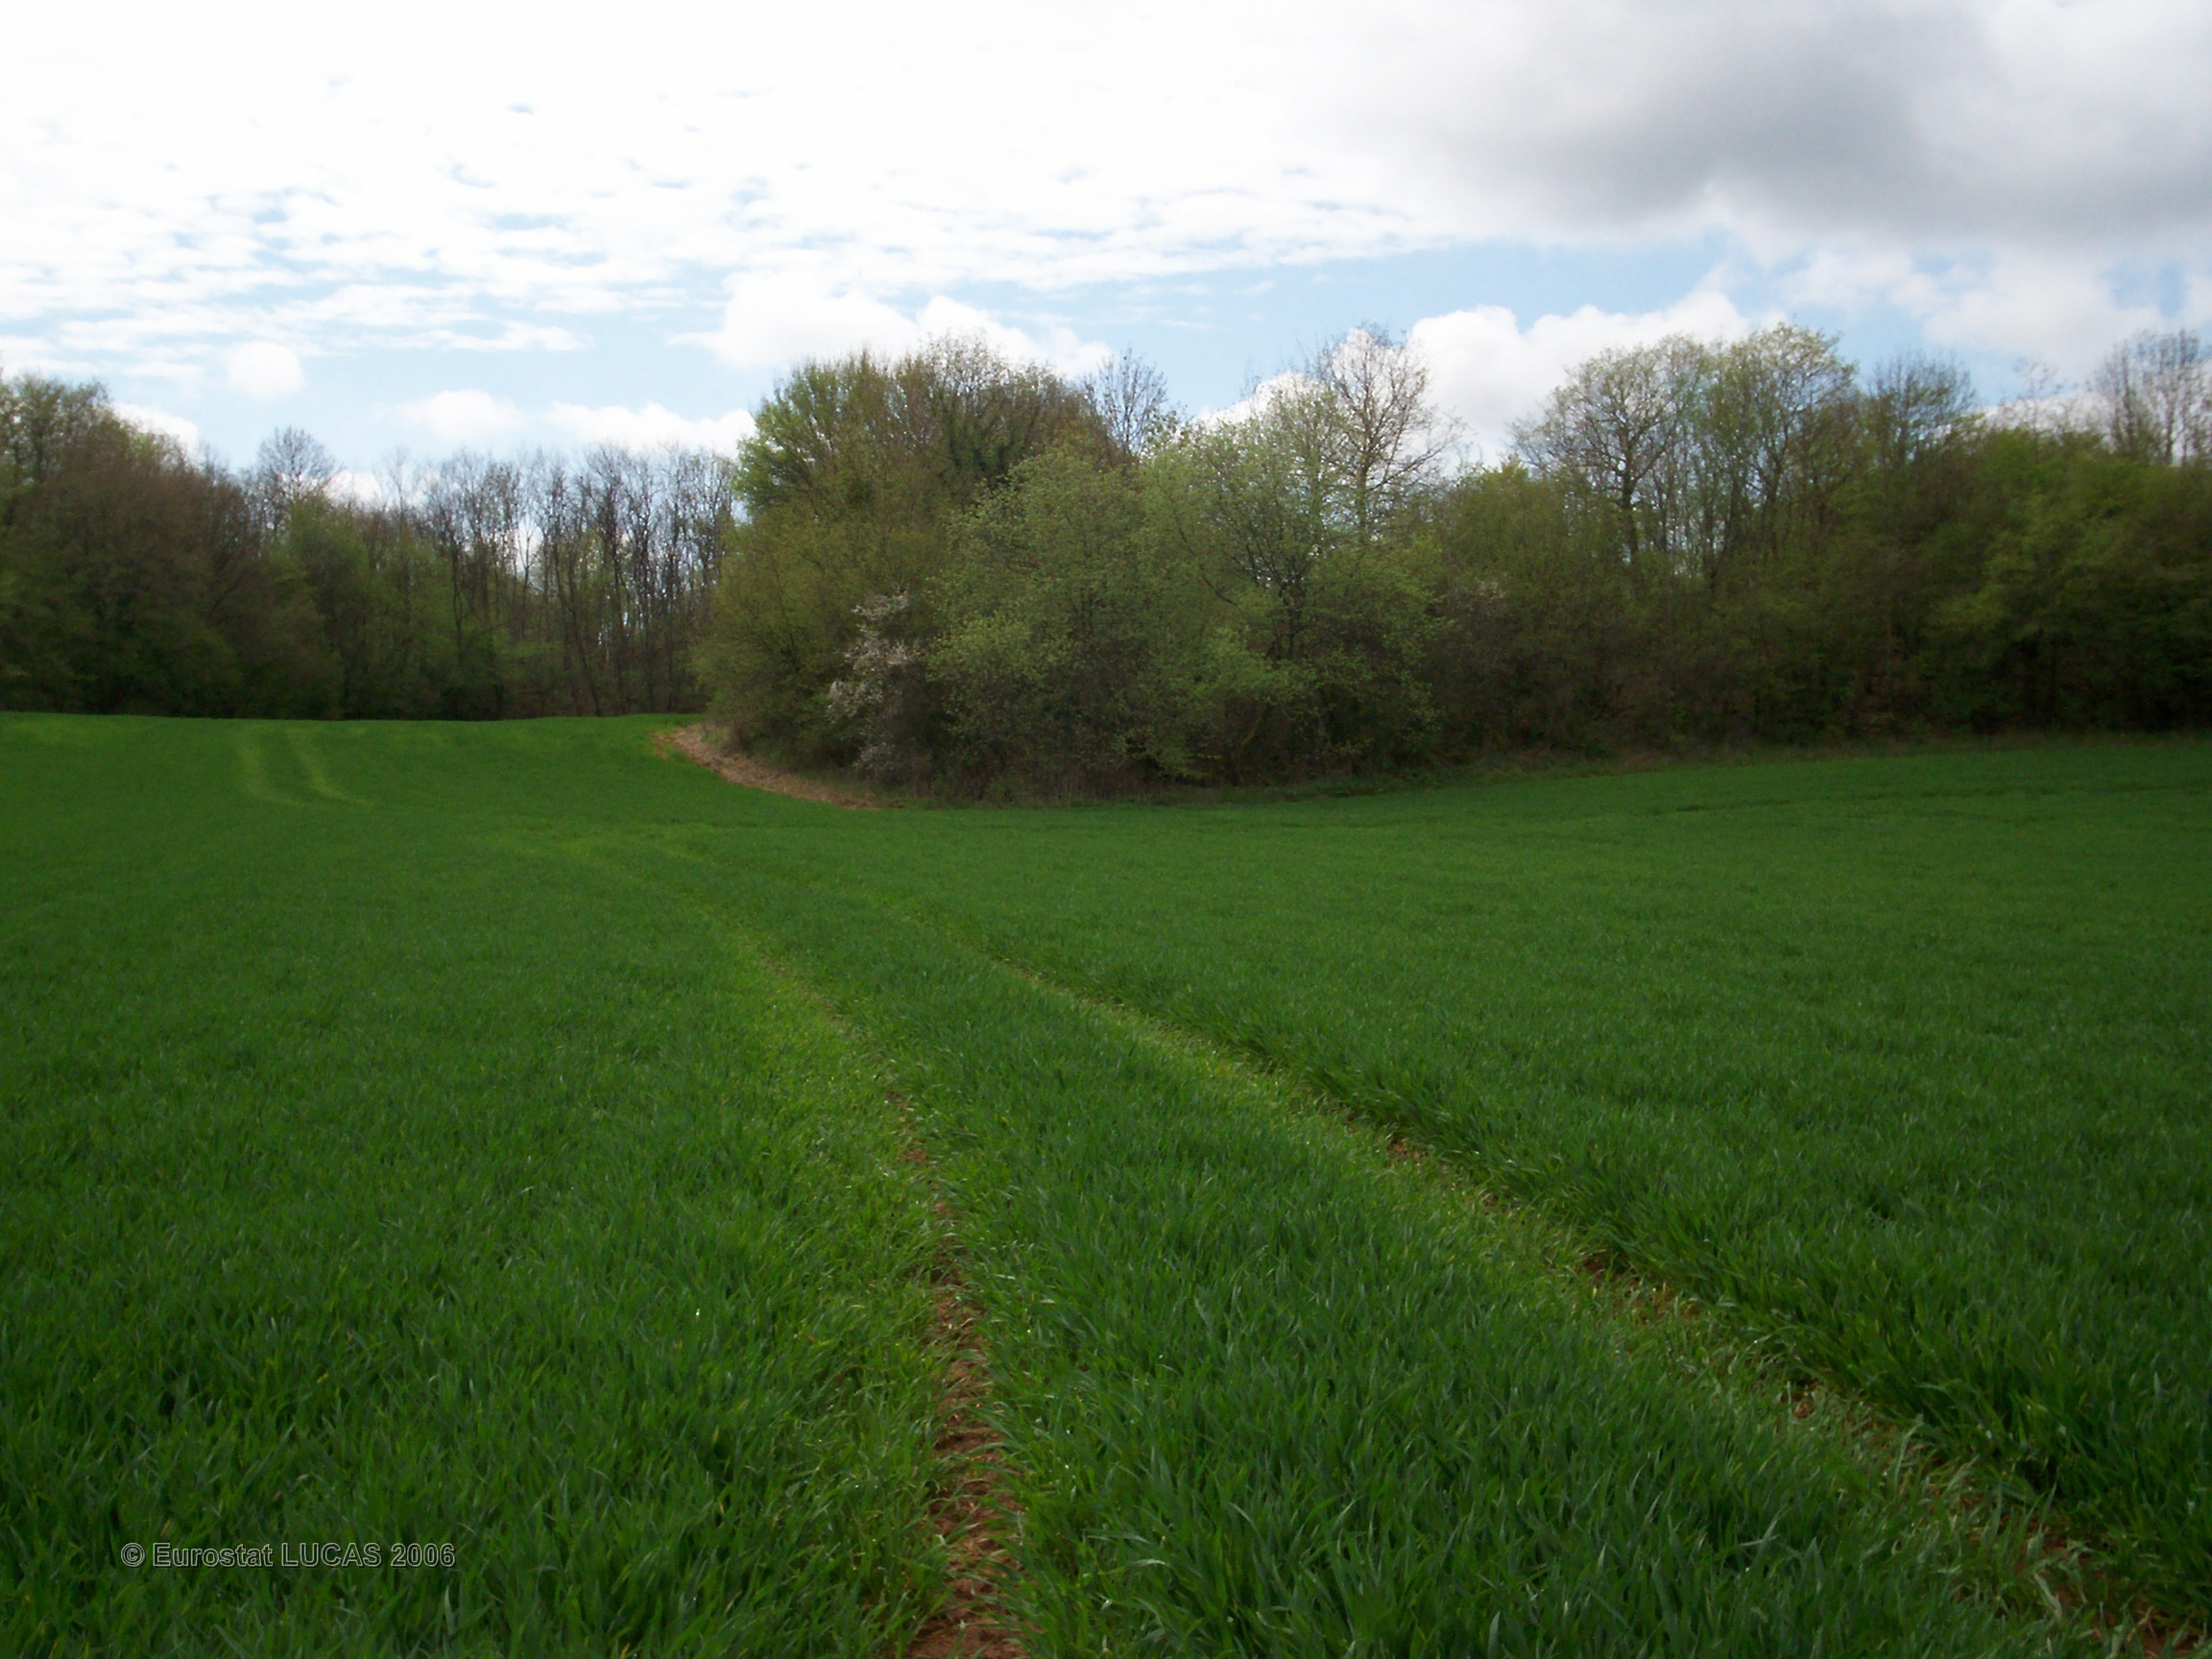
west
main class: Cropland
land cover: Common wheat
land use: Agriculture (excluding fallow land and kitchen gardens)
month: April
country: FR
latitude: 47.6132
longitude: 6.0766
